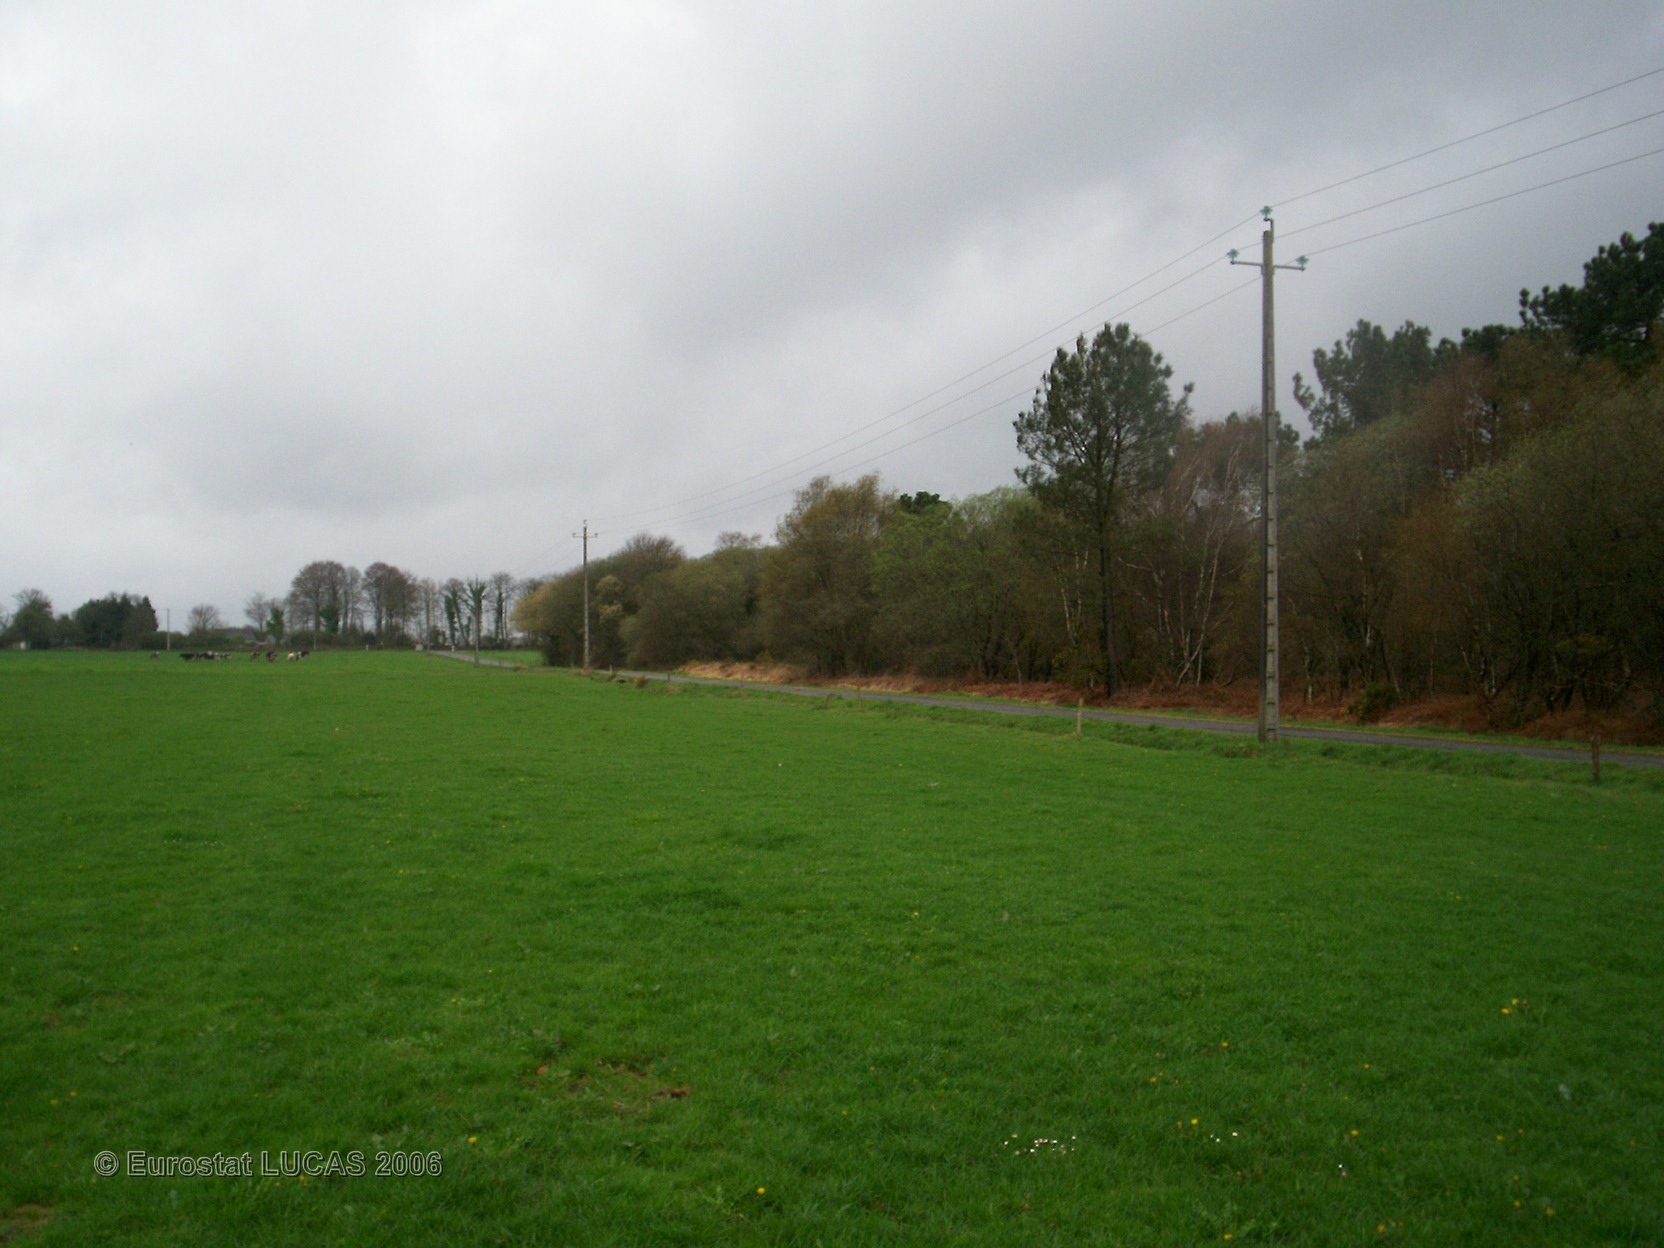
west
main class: Grassland
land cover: Grassland without tree/shrub cover
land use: Agriculture (excluding fallow land and kitchen gardens)
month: April
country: FR
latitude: 47.8821
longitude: -2.8893
